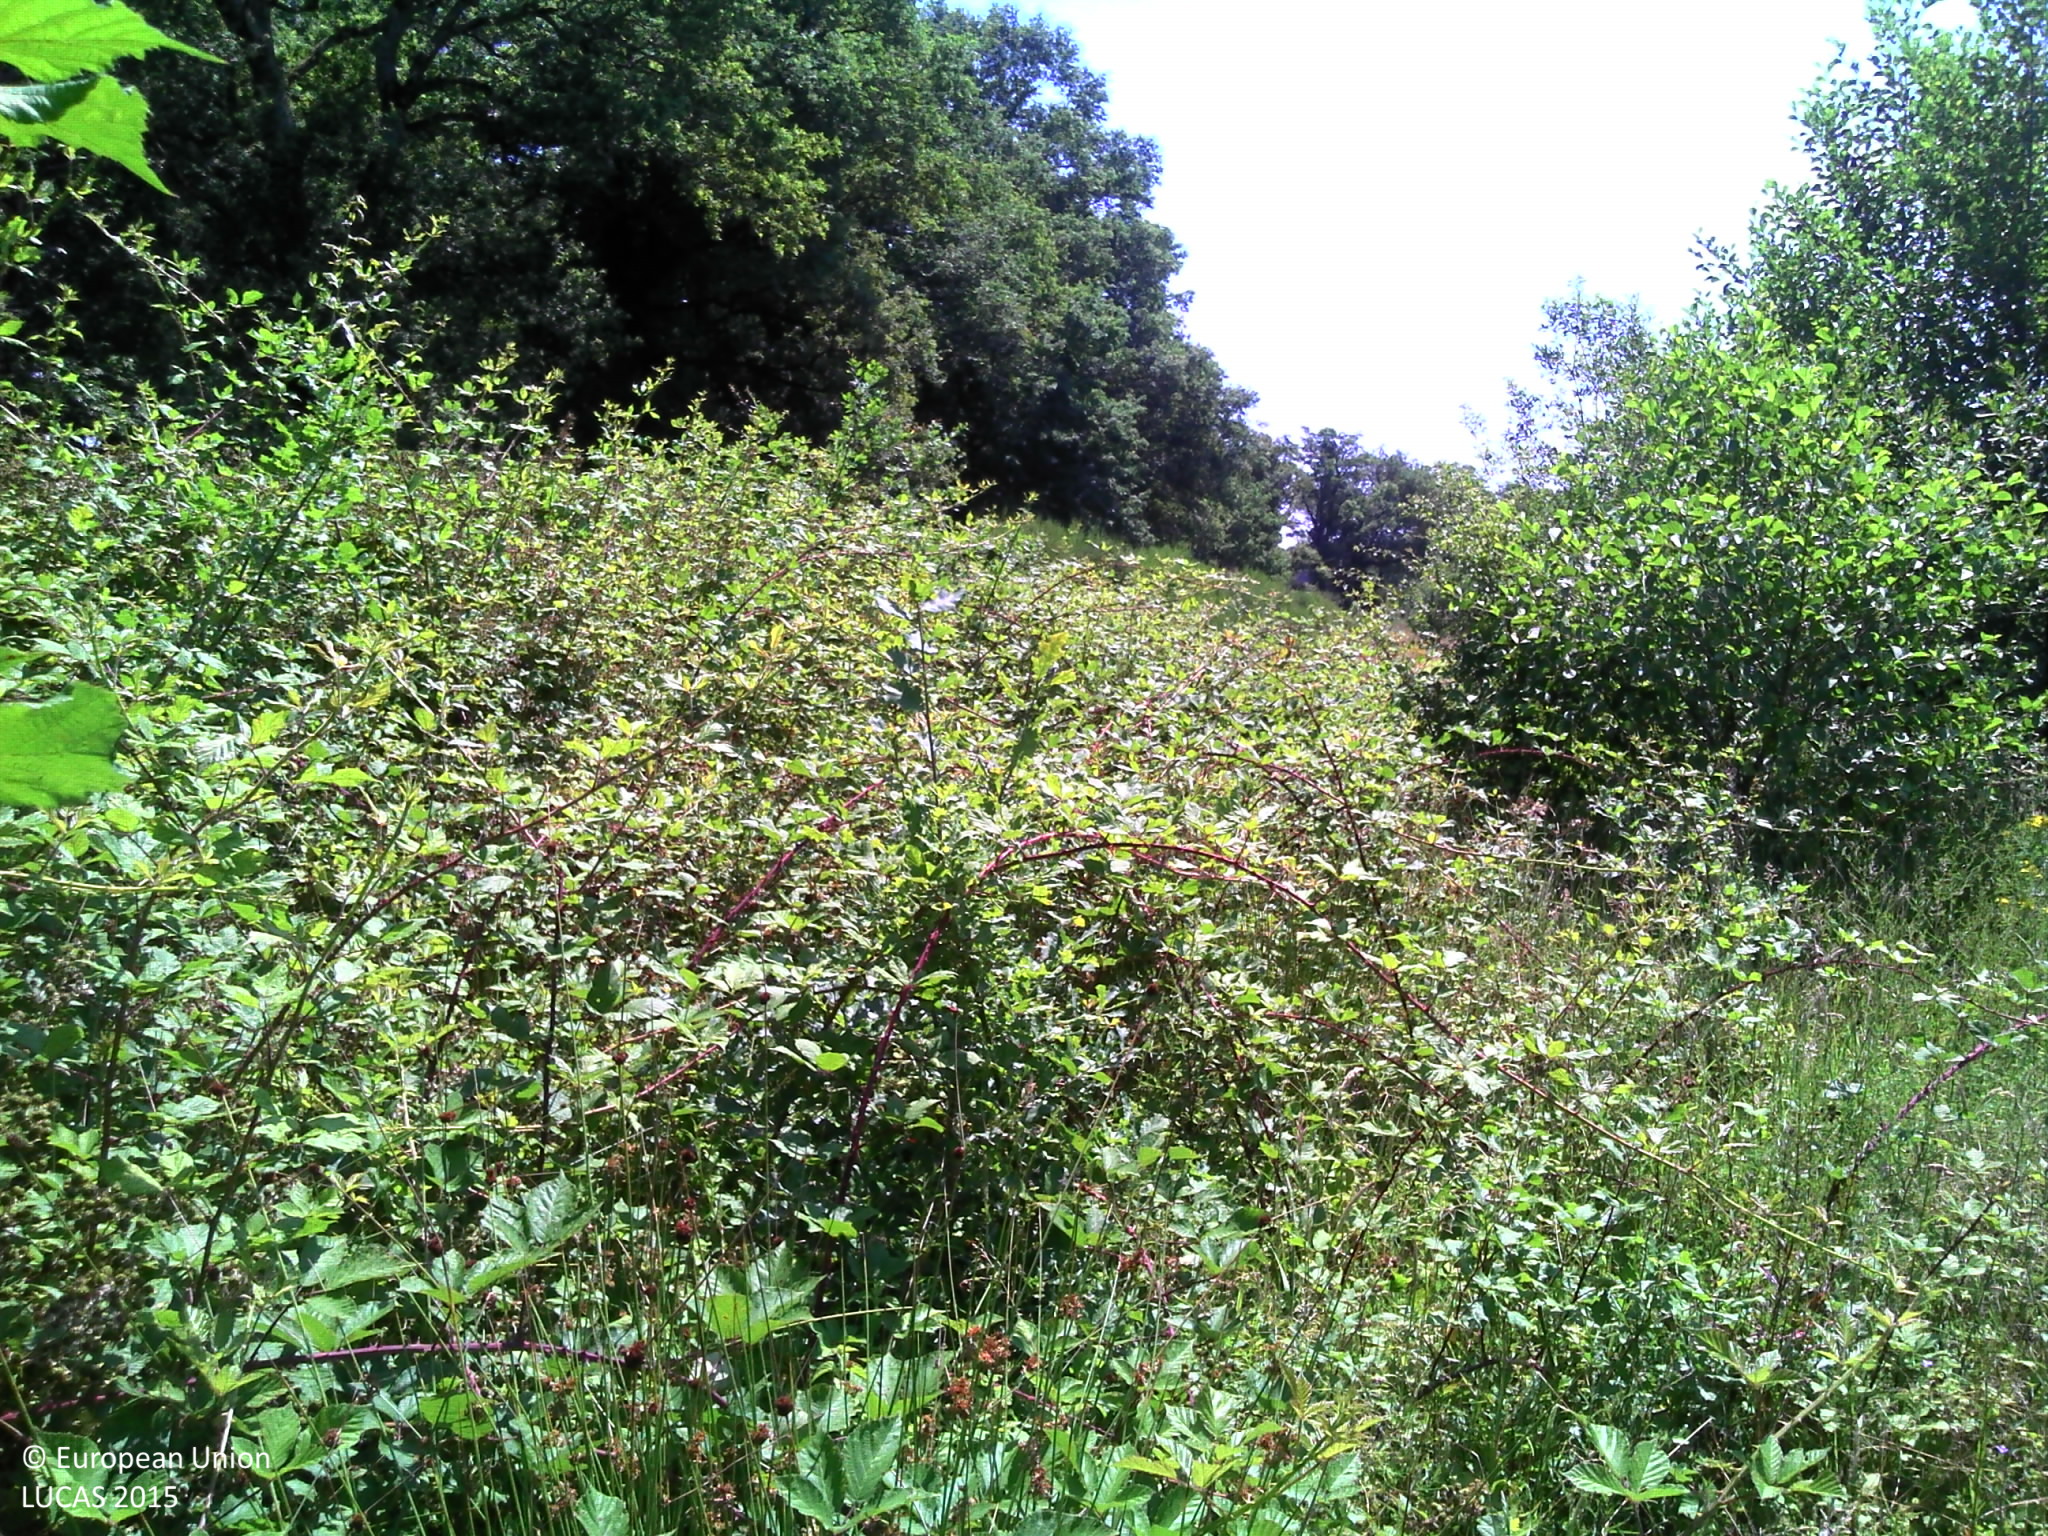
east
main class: Shrubland
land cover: Shrubland without tree cover
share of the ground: > 75 %
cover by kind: shrubs 55 %, herbaceous plants 45 %
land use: Abandoned areas
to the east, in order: Shrubland without tree cover; Fences; Lines of trees; Ditches and canals; Grass margins; Tracks; Grass margins; Ditches and canals; Broadleaved woodland; Ditches and canals; Grassland without tree/shrub cover
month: June
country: FR
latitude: 43.6465
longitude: -0.5610
